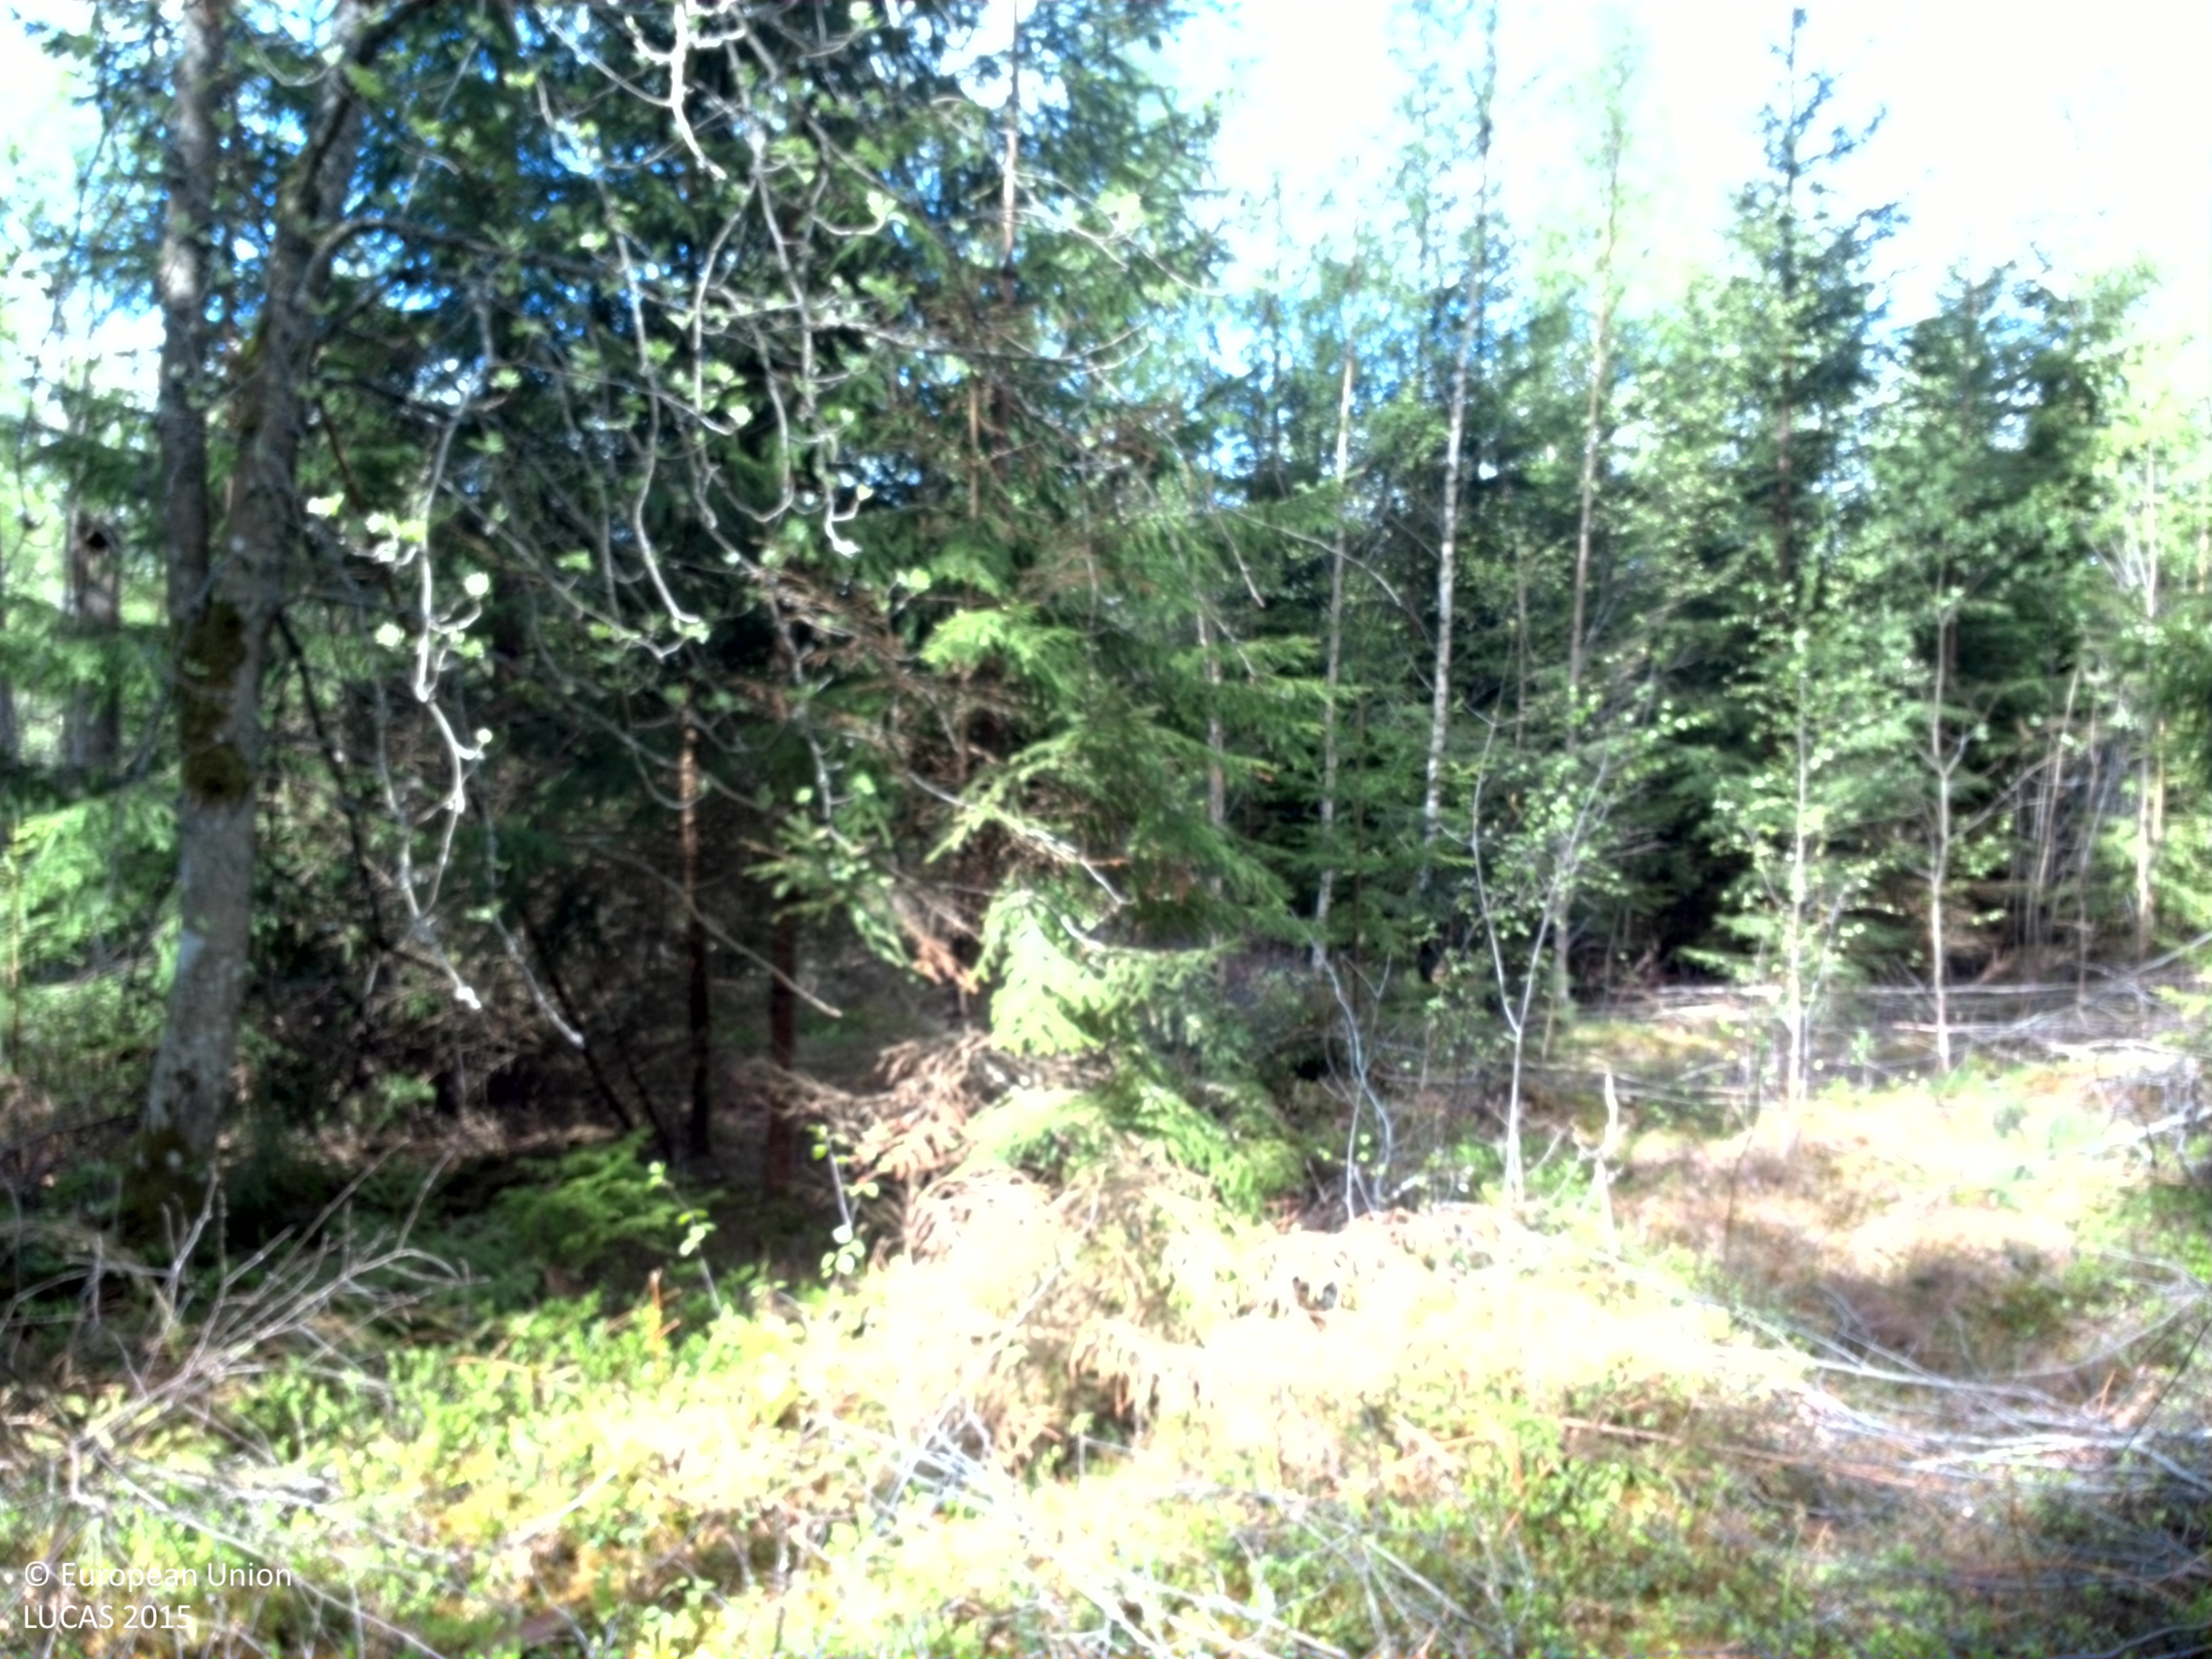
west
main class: Woodland
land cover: Pine dominated coniferous woodland
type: boreal forest
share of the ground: > 75 %
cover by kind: coniferous forest trees 60 %, broadleaved forest trees 20 %, lichens and mosses 10 %, shrubs 5 %, herbaceous plants 5 %
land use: Forestry
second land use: Amenities, museums, leisure
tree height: > 5 m
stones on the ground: < 10 %
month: May
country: SE
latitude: 56.9095
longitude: 14.7761
